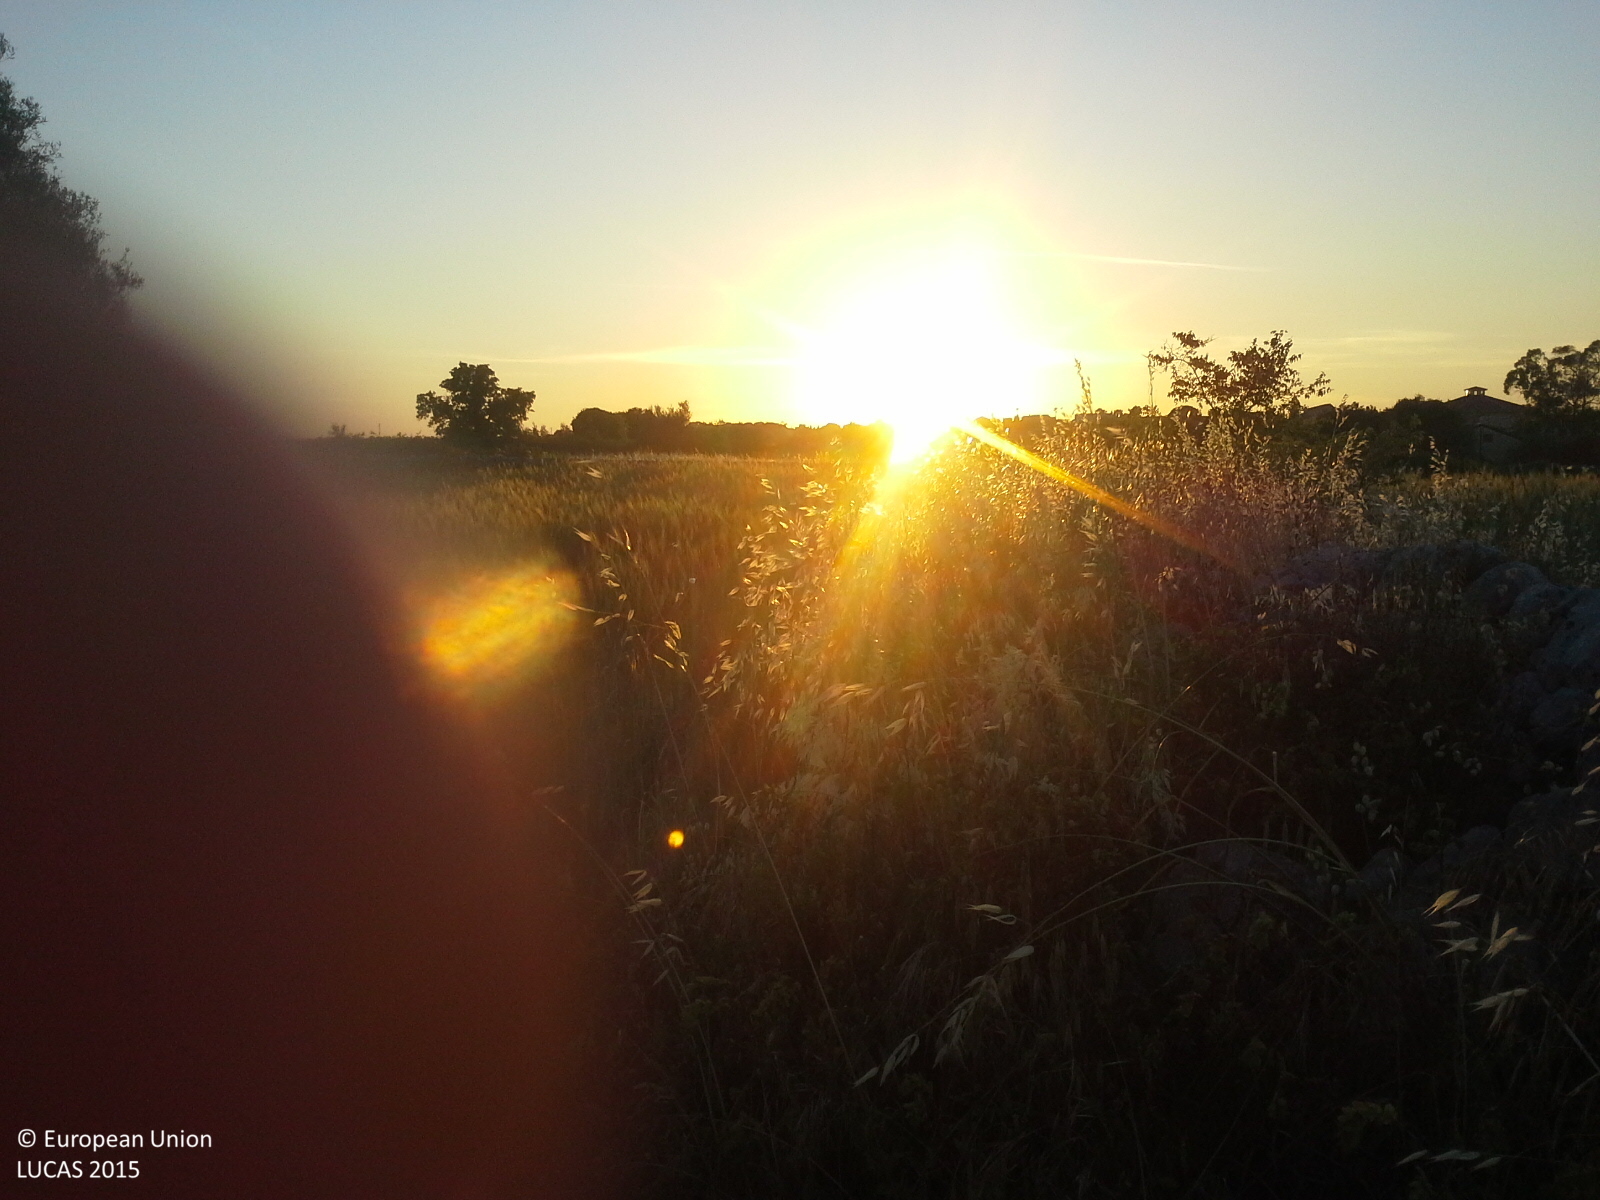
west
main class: Cropland
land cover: Durum wheat
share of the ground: > 75 %
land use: Agriculture (excluding fallow land and kitchen gardens)
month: May
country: IT
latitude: 36.8251
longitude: 14.8159
